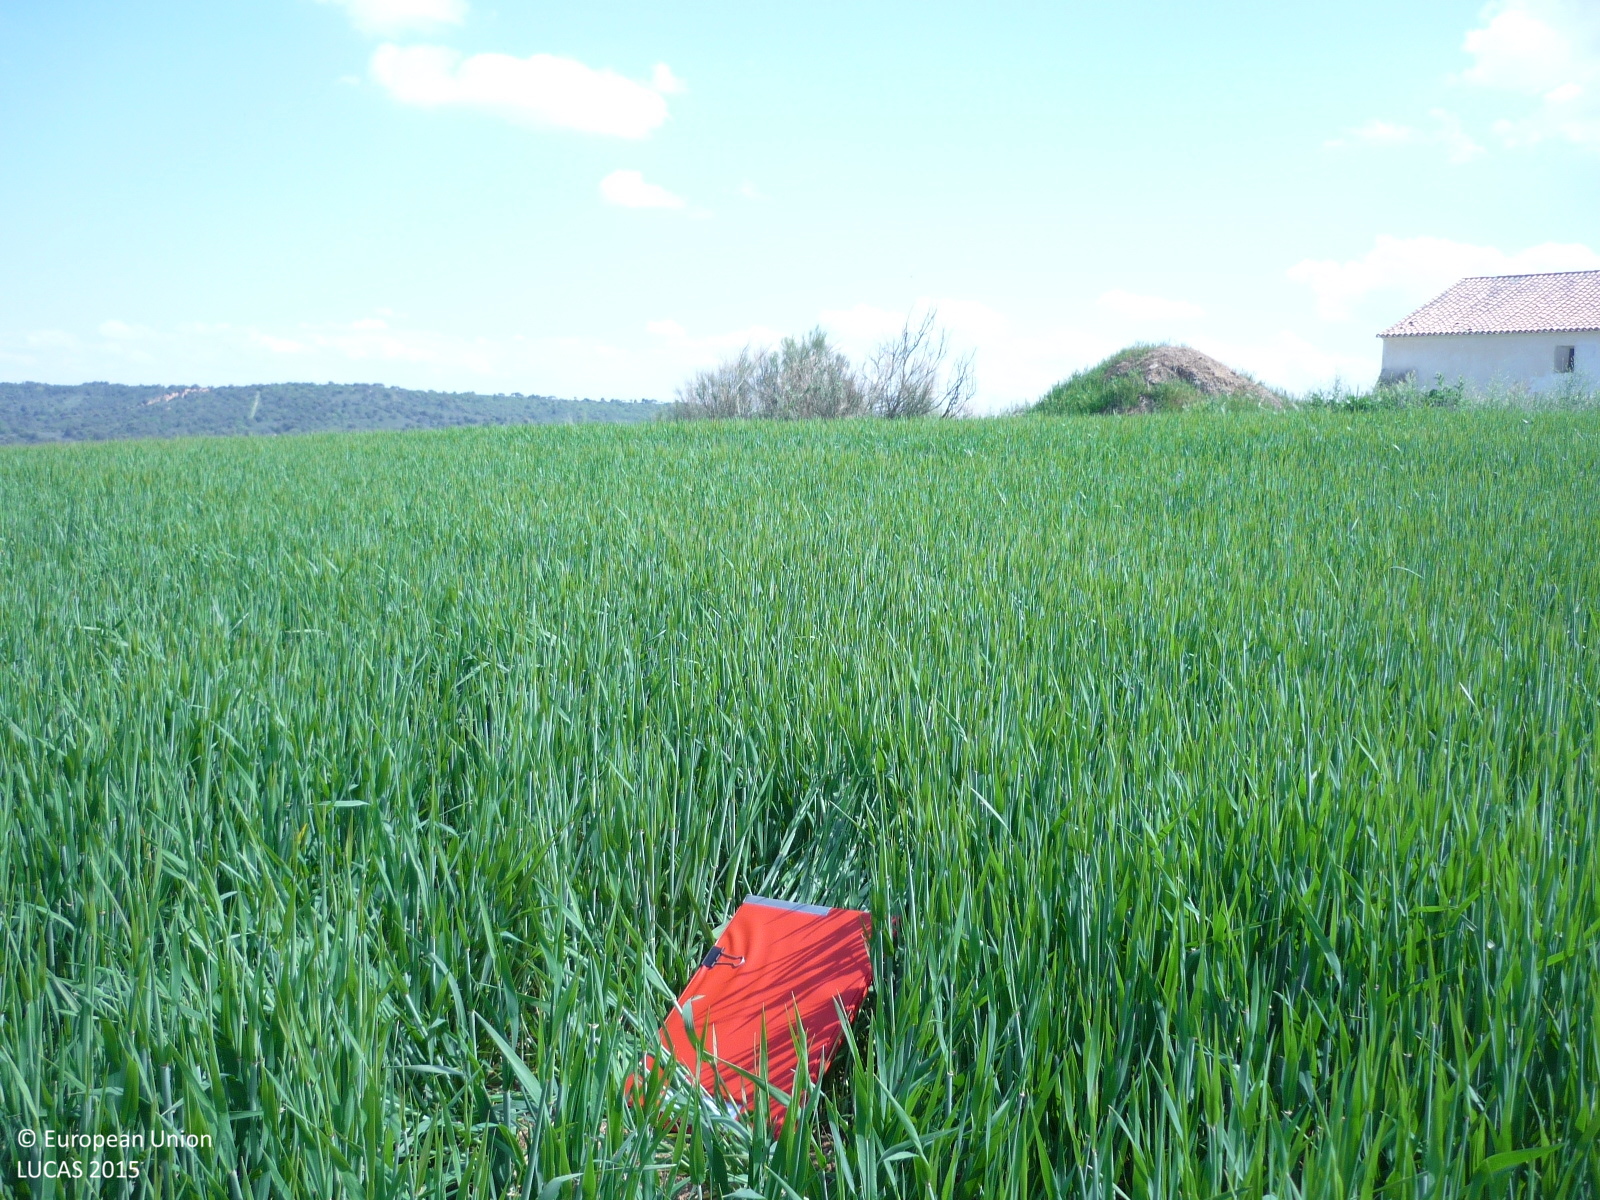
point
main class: Cropland
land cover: Barley
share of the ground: > 75 %
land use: Agriculture (excluding fallow land and kitchen gardens)
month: April
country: ES
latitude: 40.7809
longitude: -3.4643
